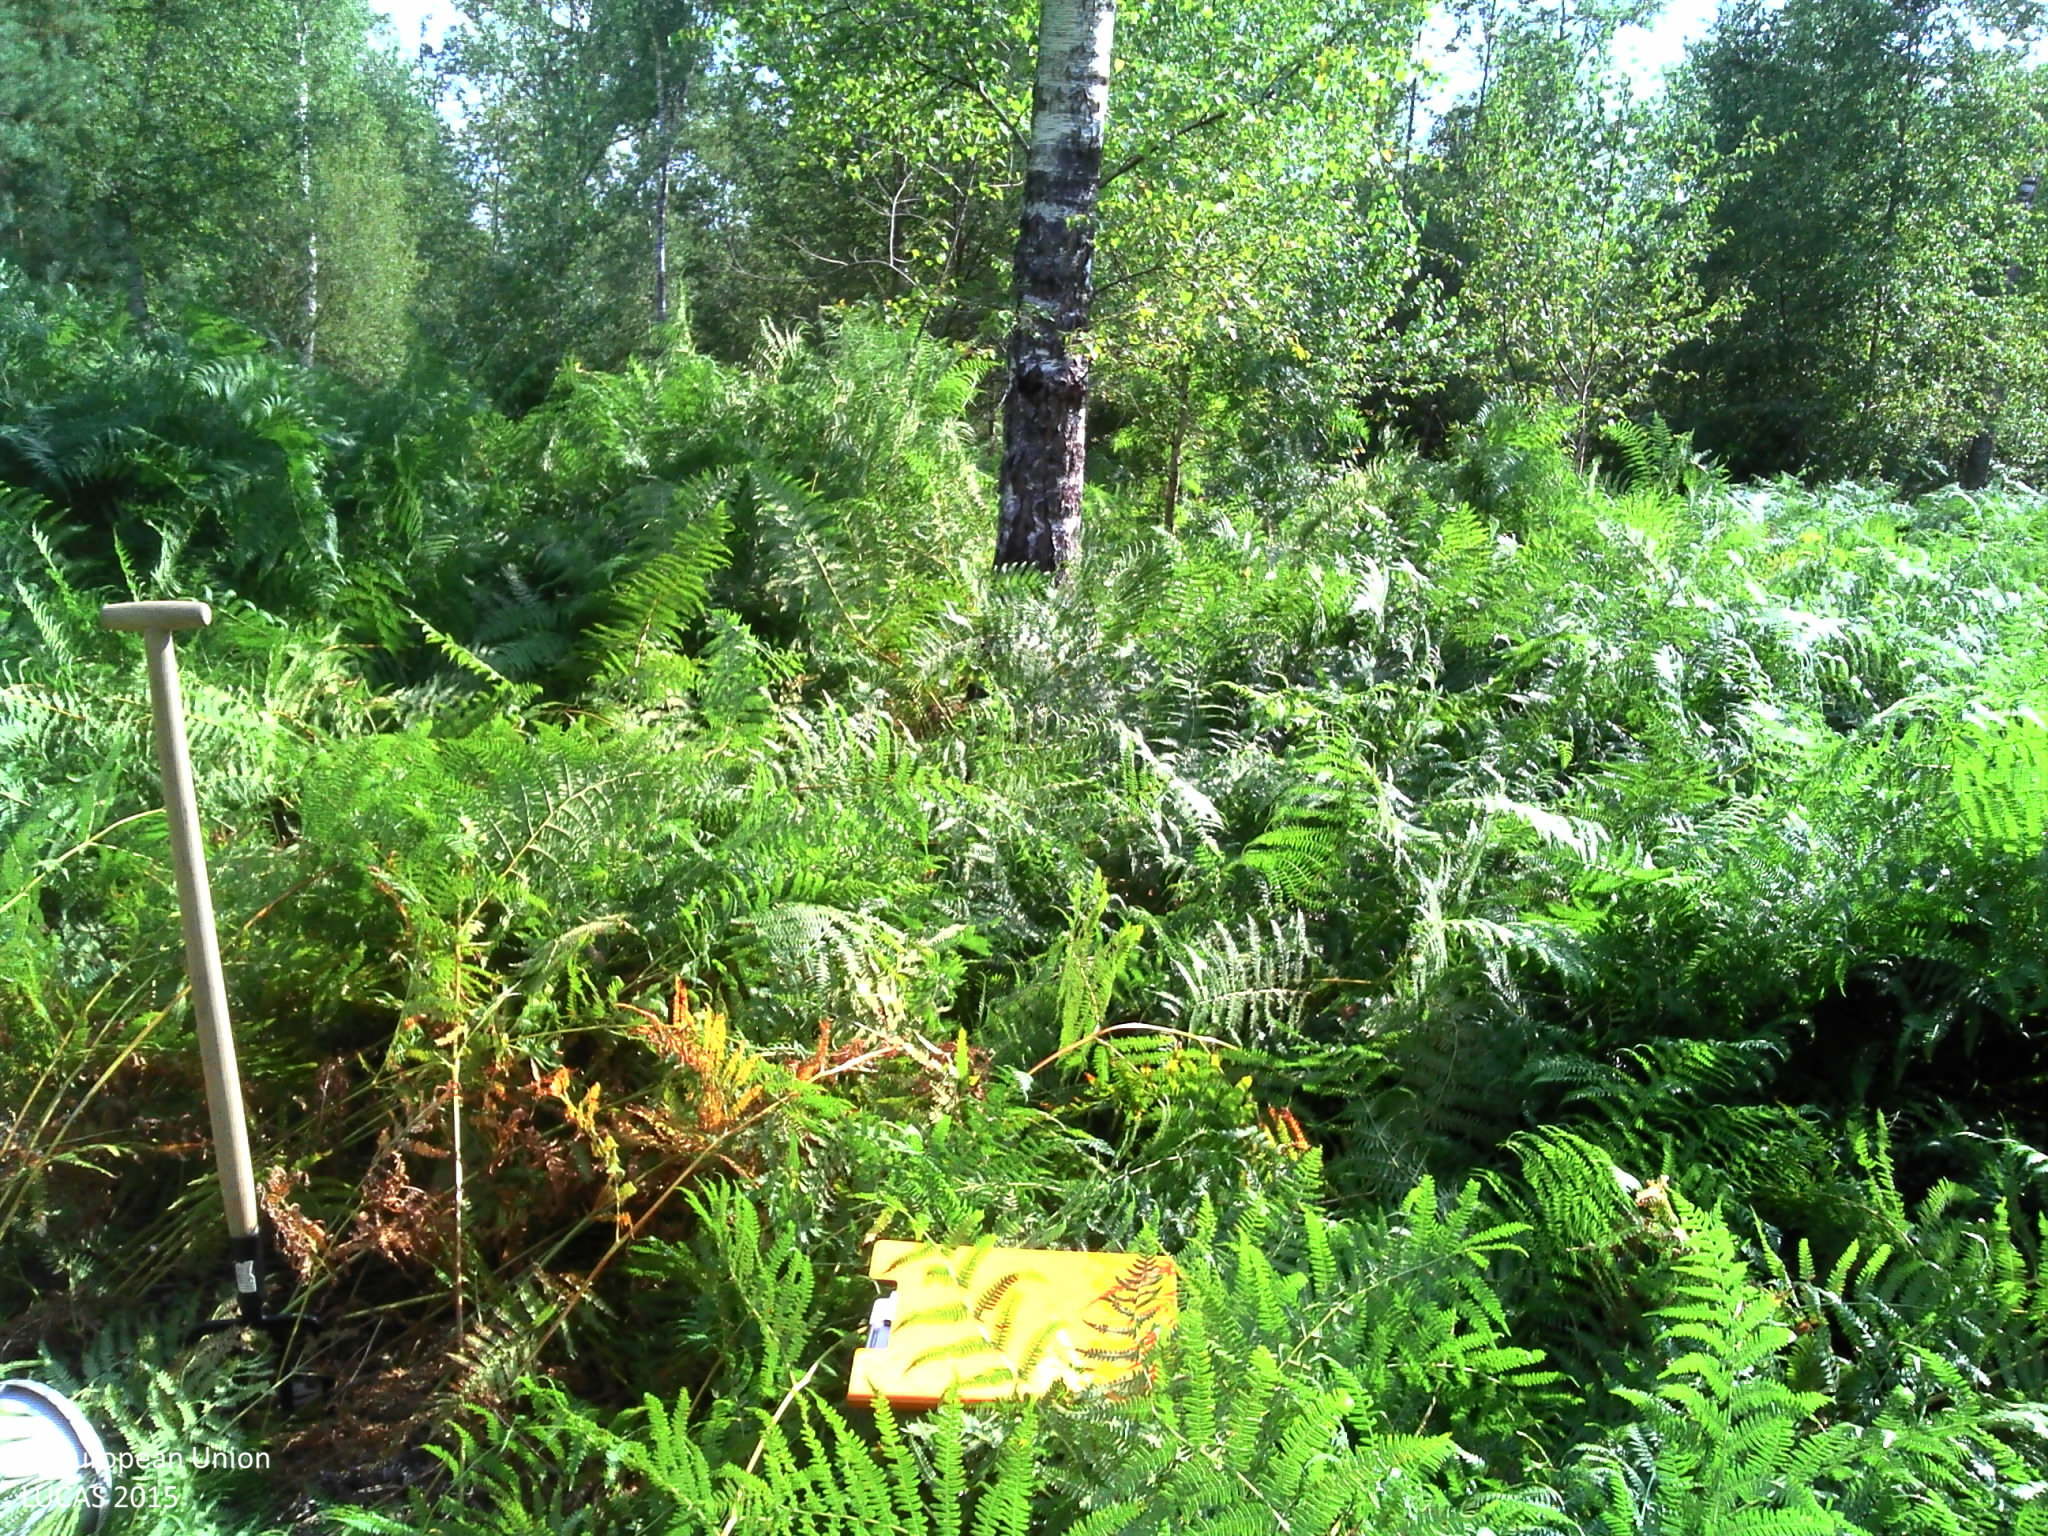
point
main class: Woodland
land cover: Broadleaved woodland
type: acidophilous oak and oak-birch forest
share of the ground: 25 - 50 %
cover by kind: herbaceous plants 60 %, broadleaved forest trees 40 %
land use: Forestry
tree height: > 5 m
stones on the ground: < 10 %
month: August
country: FR
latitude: 47.3639
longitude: 2.1385
